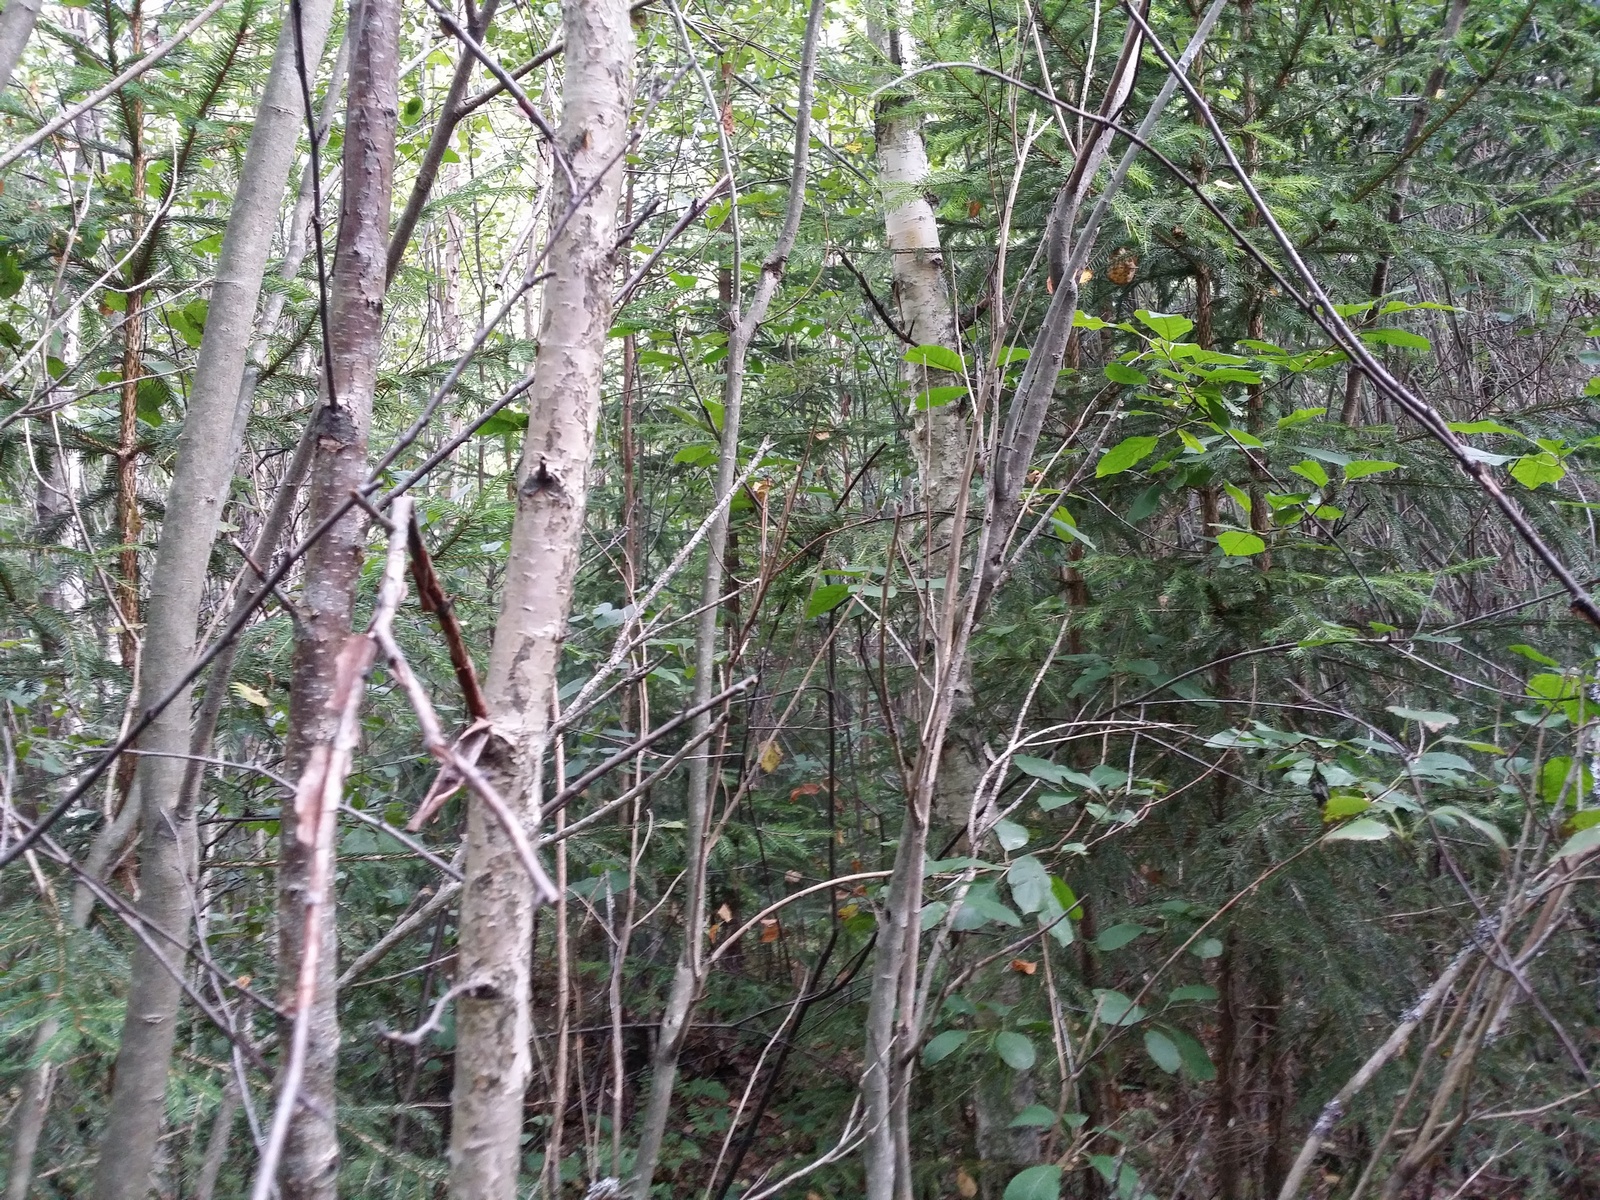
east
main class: Woodland
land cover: Spruce dominated mixed woodland
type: hemiboreal forest and nemoral coniferous forest and mixed broadleaved-coniferous forest
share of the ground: > 75 %
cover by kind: coniferous forest trees 50 %, broadleaved forest trees 40 %, shrubs 5 %, lichens and mosses 5 %
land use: Forestry
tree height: > 5 m
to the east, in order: Spruce dominated mixed woodland; Other mixed woodland; Spruce dominated coniferous woodland; Broadleaved woodland; Shrubland with sparse tree cover; Other coniferous woodland
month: August
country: LV
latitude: 57.3292
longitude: 27.6707
